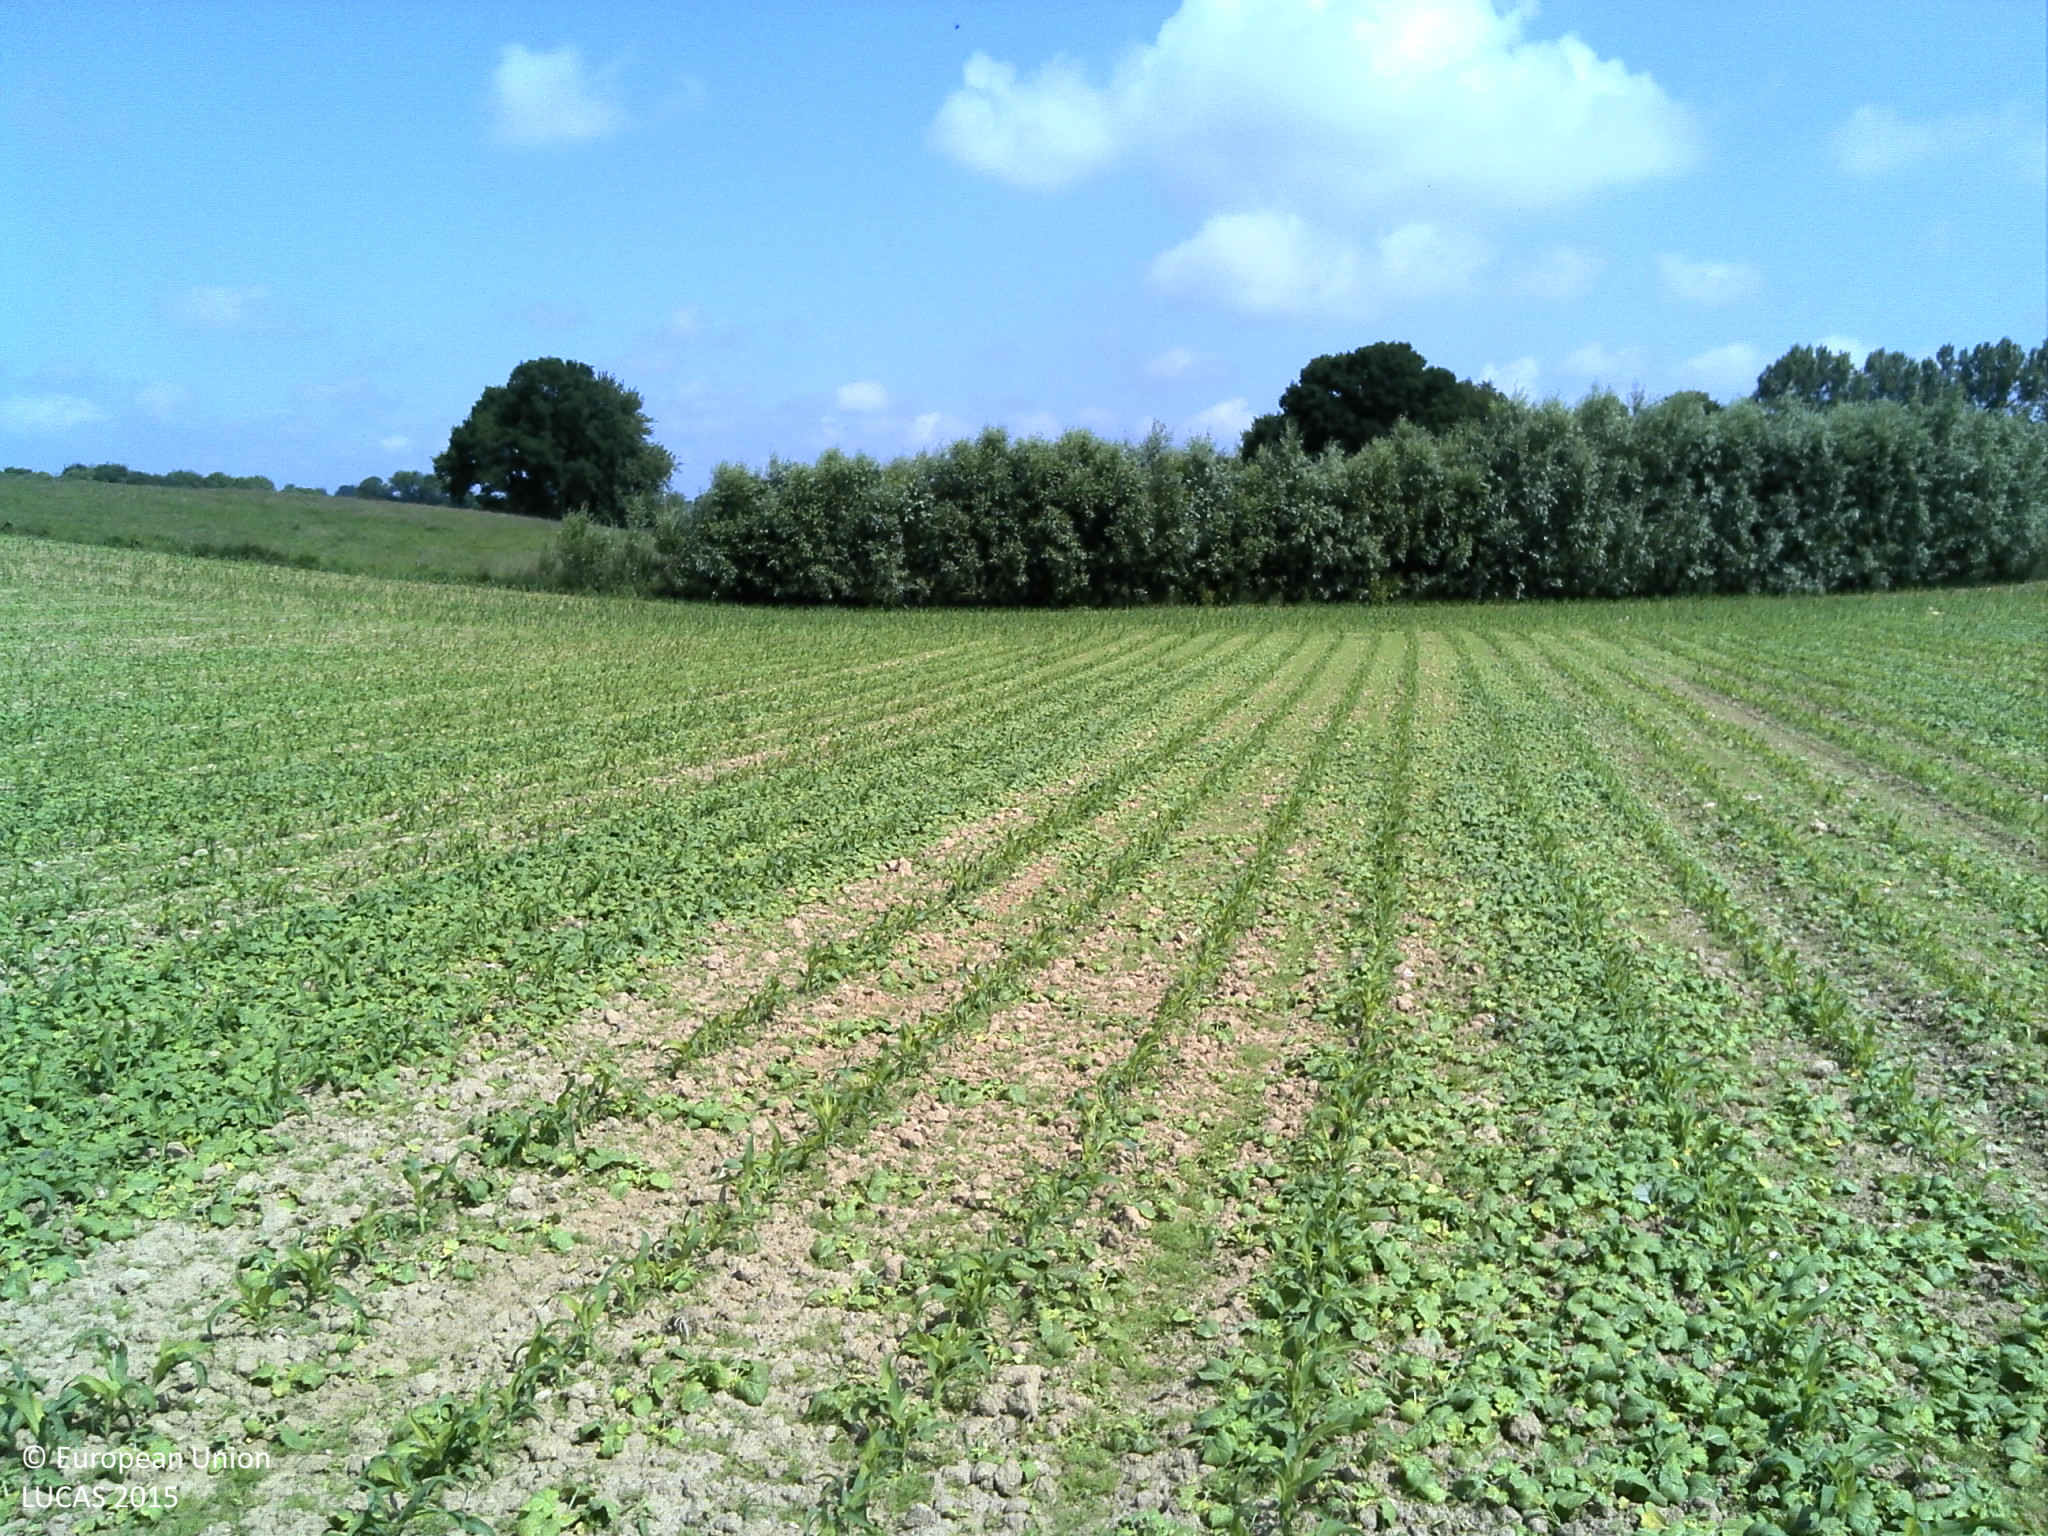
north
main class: Cropland
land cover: Maize
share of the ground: 10 - 25 %
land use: Agriculture (excluding fallow land and kitchen gardens)
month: June
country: FR
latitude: 49.5431
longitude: 0.6181
